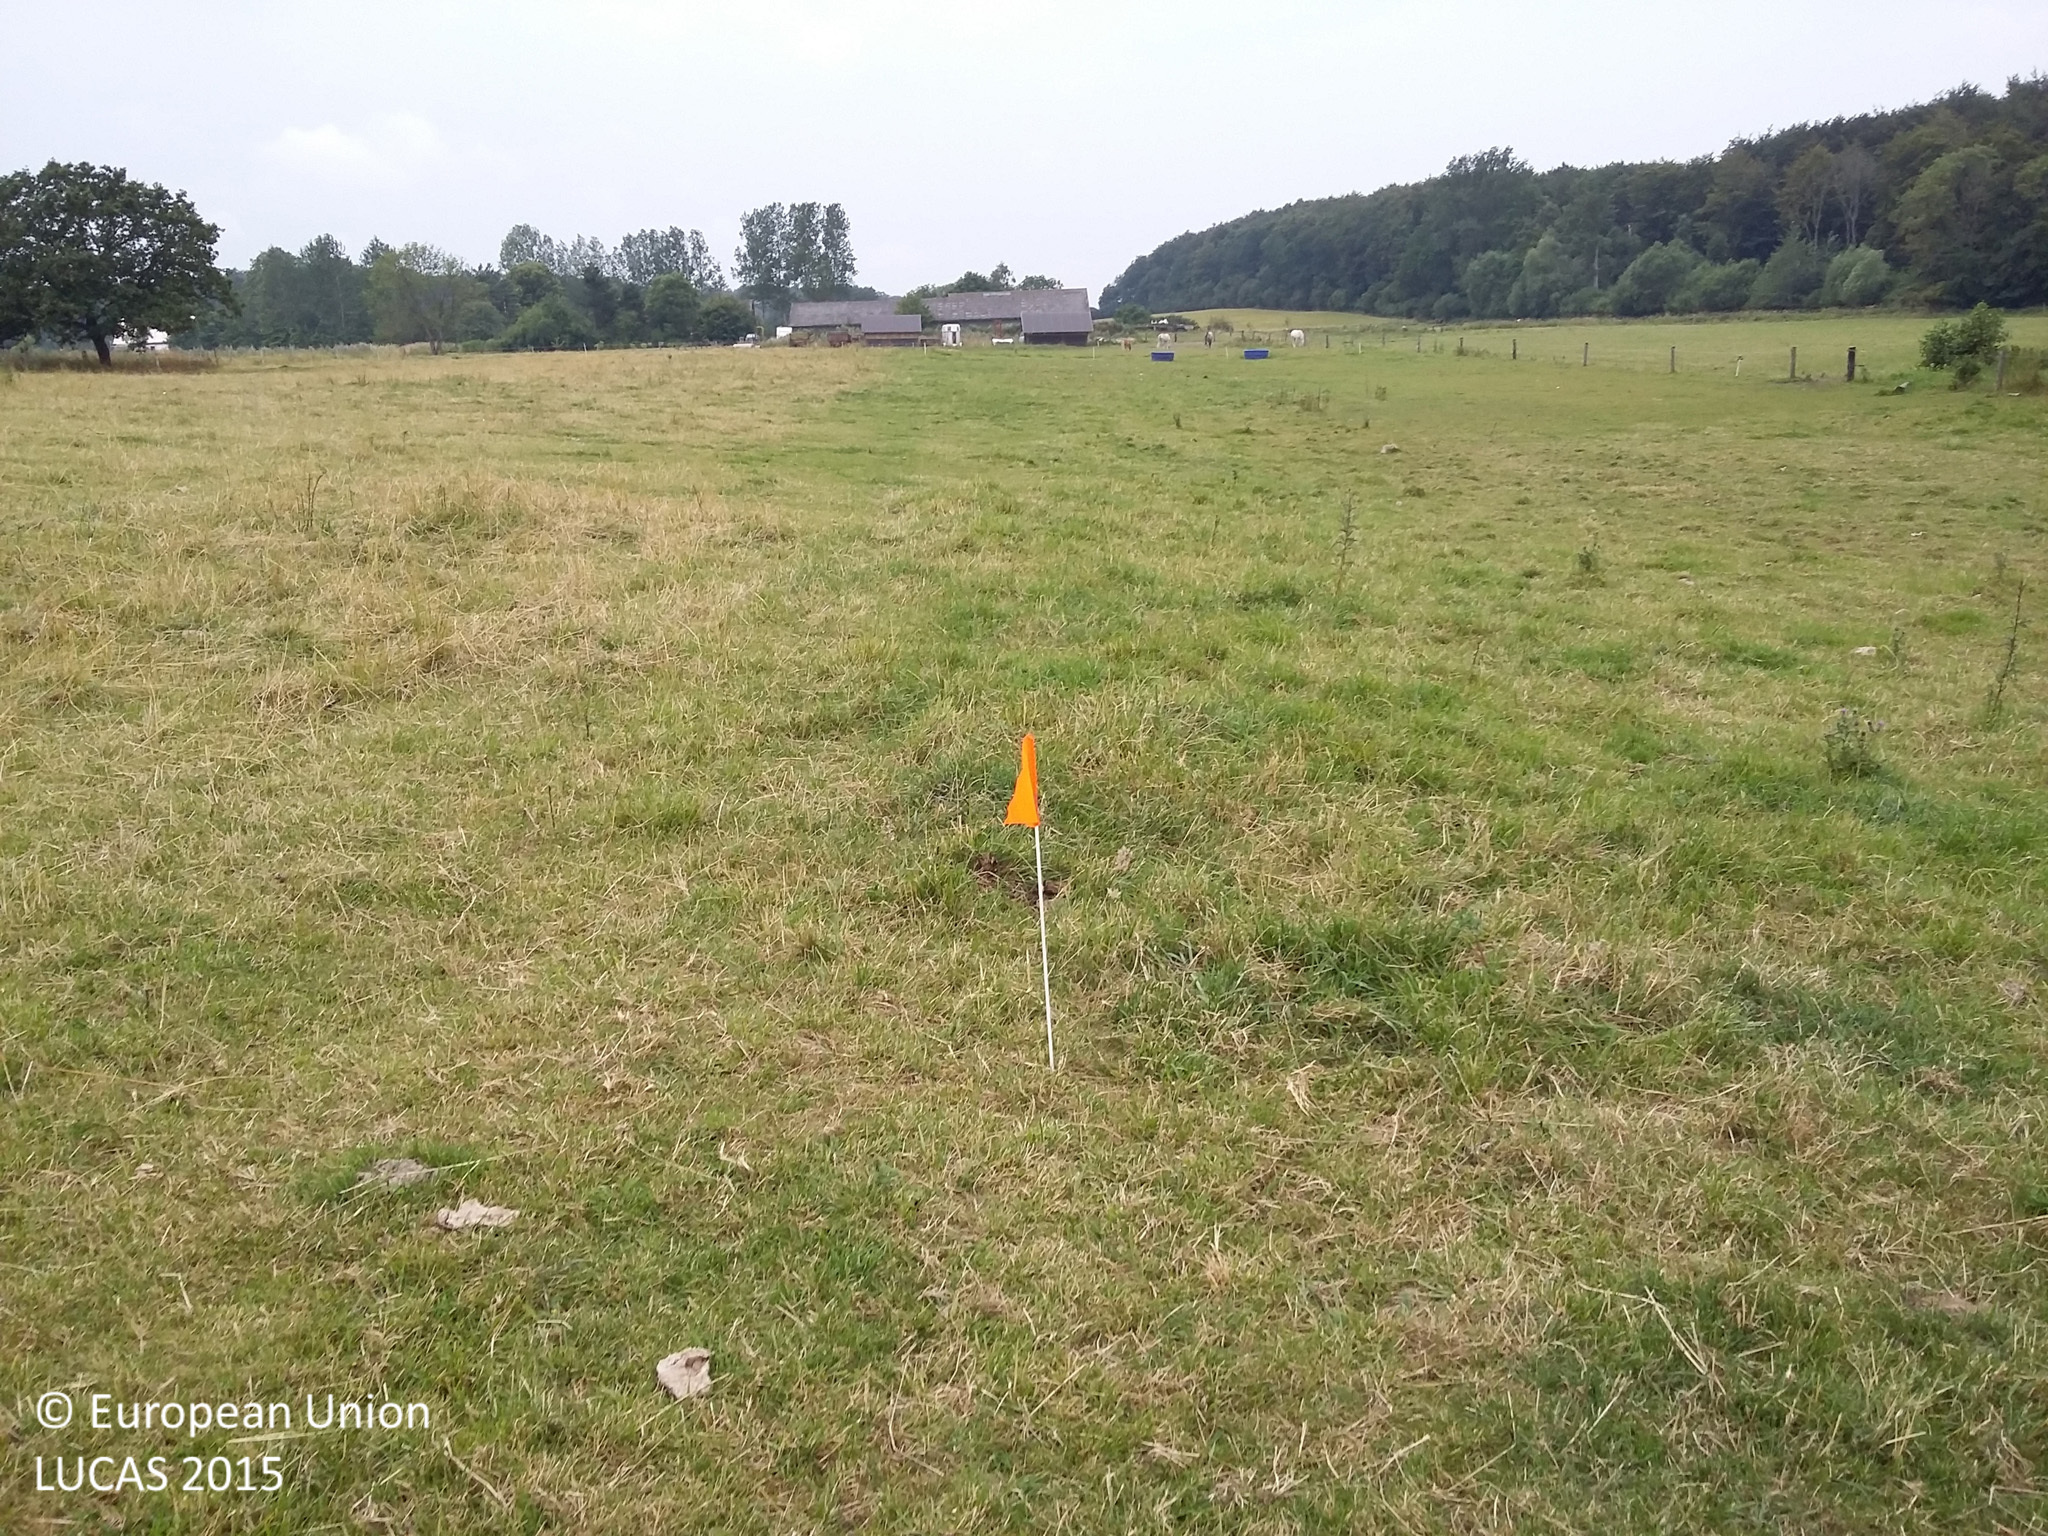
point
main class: Grassland
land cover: Grassland without tree/shrub cover
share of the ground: > 75 %
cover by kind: herbaceous plants 100 %
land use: Agriculture (excluding fallow land and kitchen gardens)
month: August
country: DK
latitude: 55.4938
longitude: 11.6605
